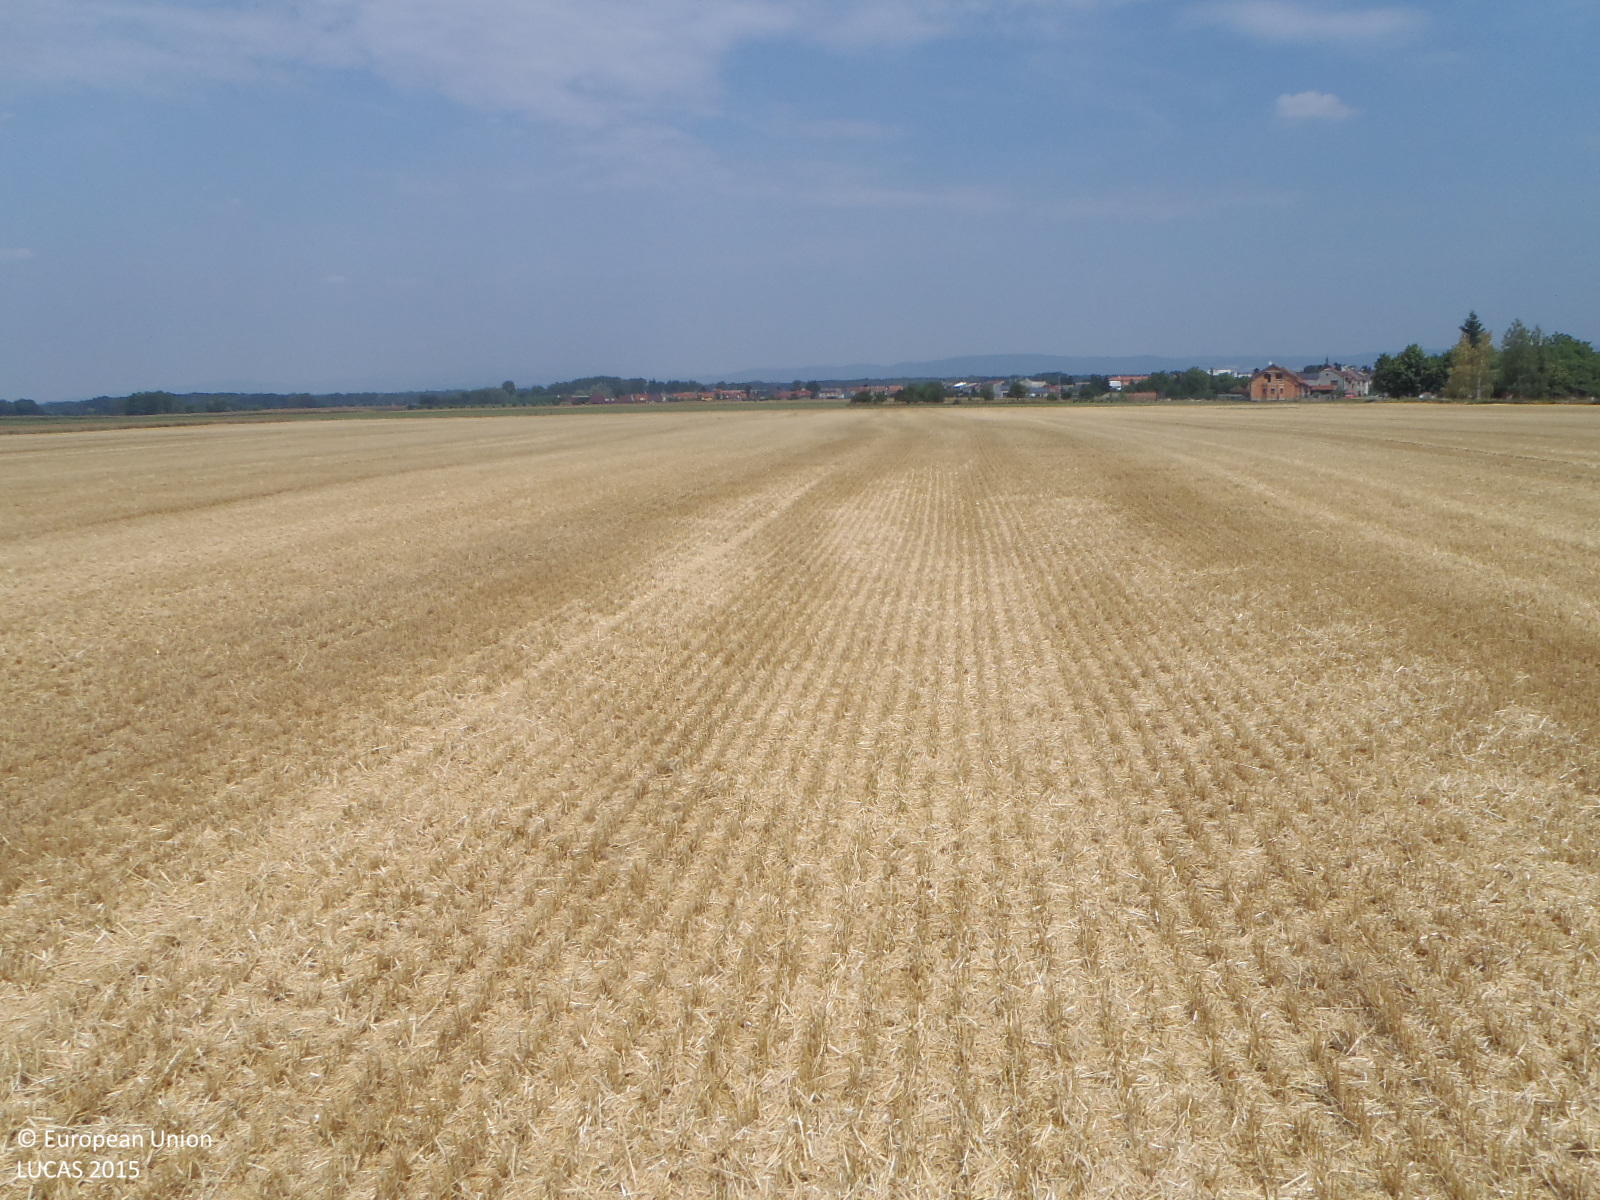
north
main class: Cropland
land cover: Barley
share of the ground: > 75 %
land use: Agriculture (excluding fallow land and kitchen gardens)
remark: Harvested field
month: July
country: CZ
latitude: 49.6335
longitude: 17.1686
